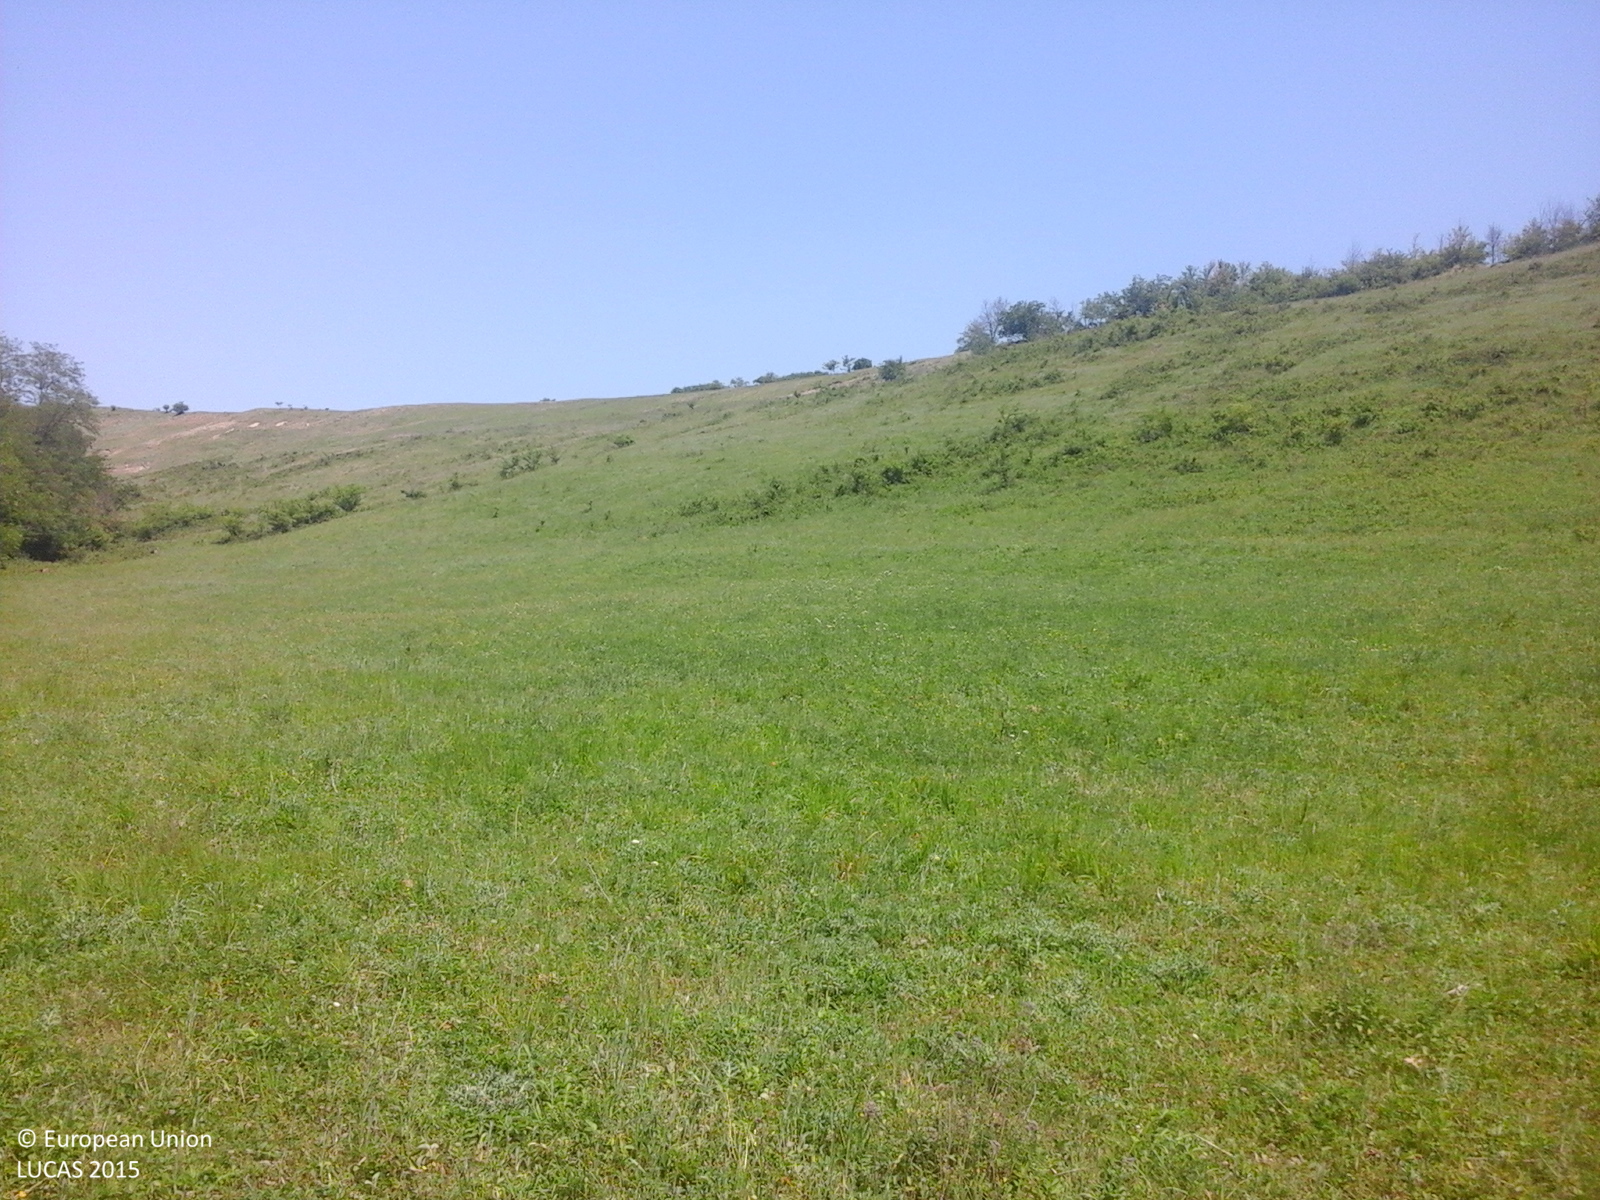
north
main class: Grassland
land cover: Grassland without tree/shrub cover
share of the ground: > 75 %
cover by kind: herbaceous plants 100 %
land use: Agriculture (excluding fallow land and kitchen gardens)
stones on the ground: < 10 %
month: June
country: RO
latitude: 46.4746
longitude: 27.0682
